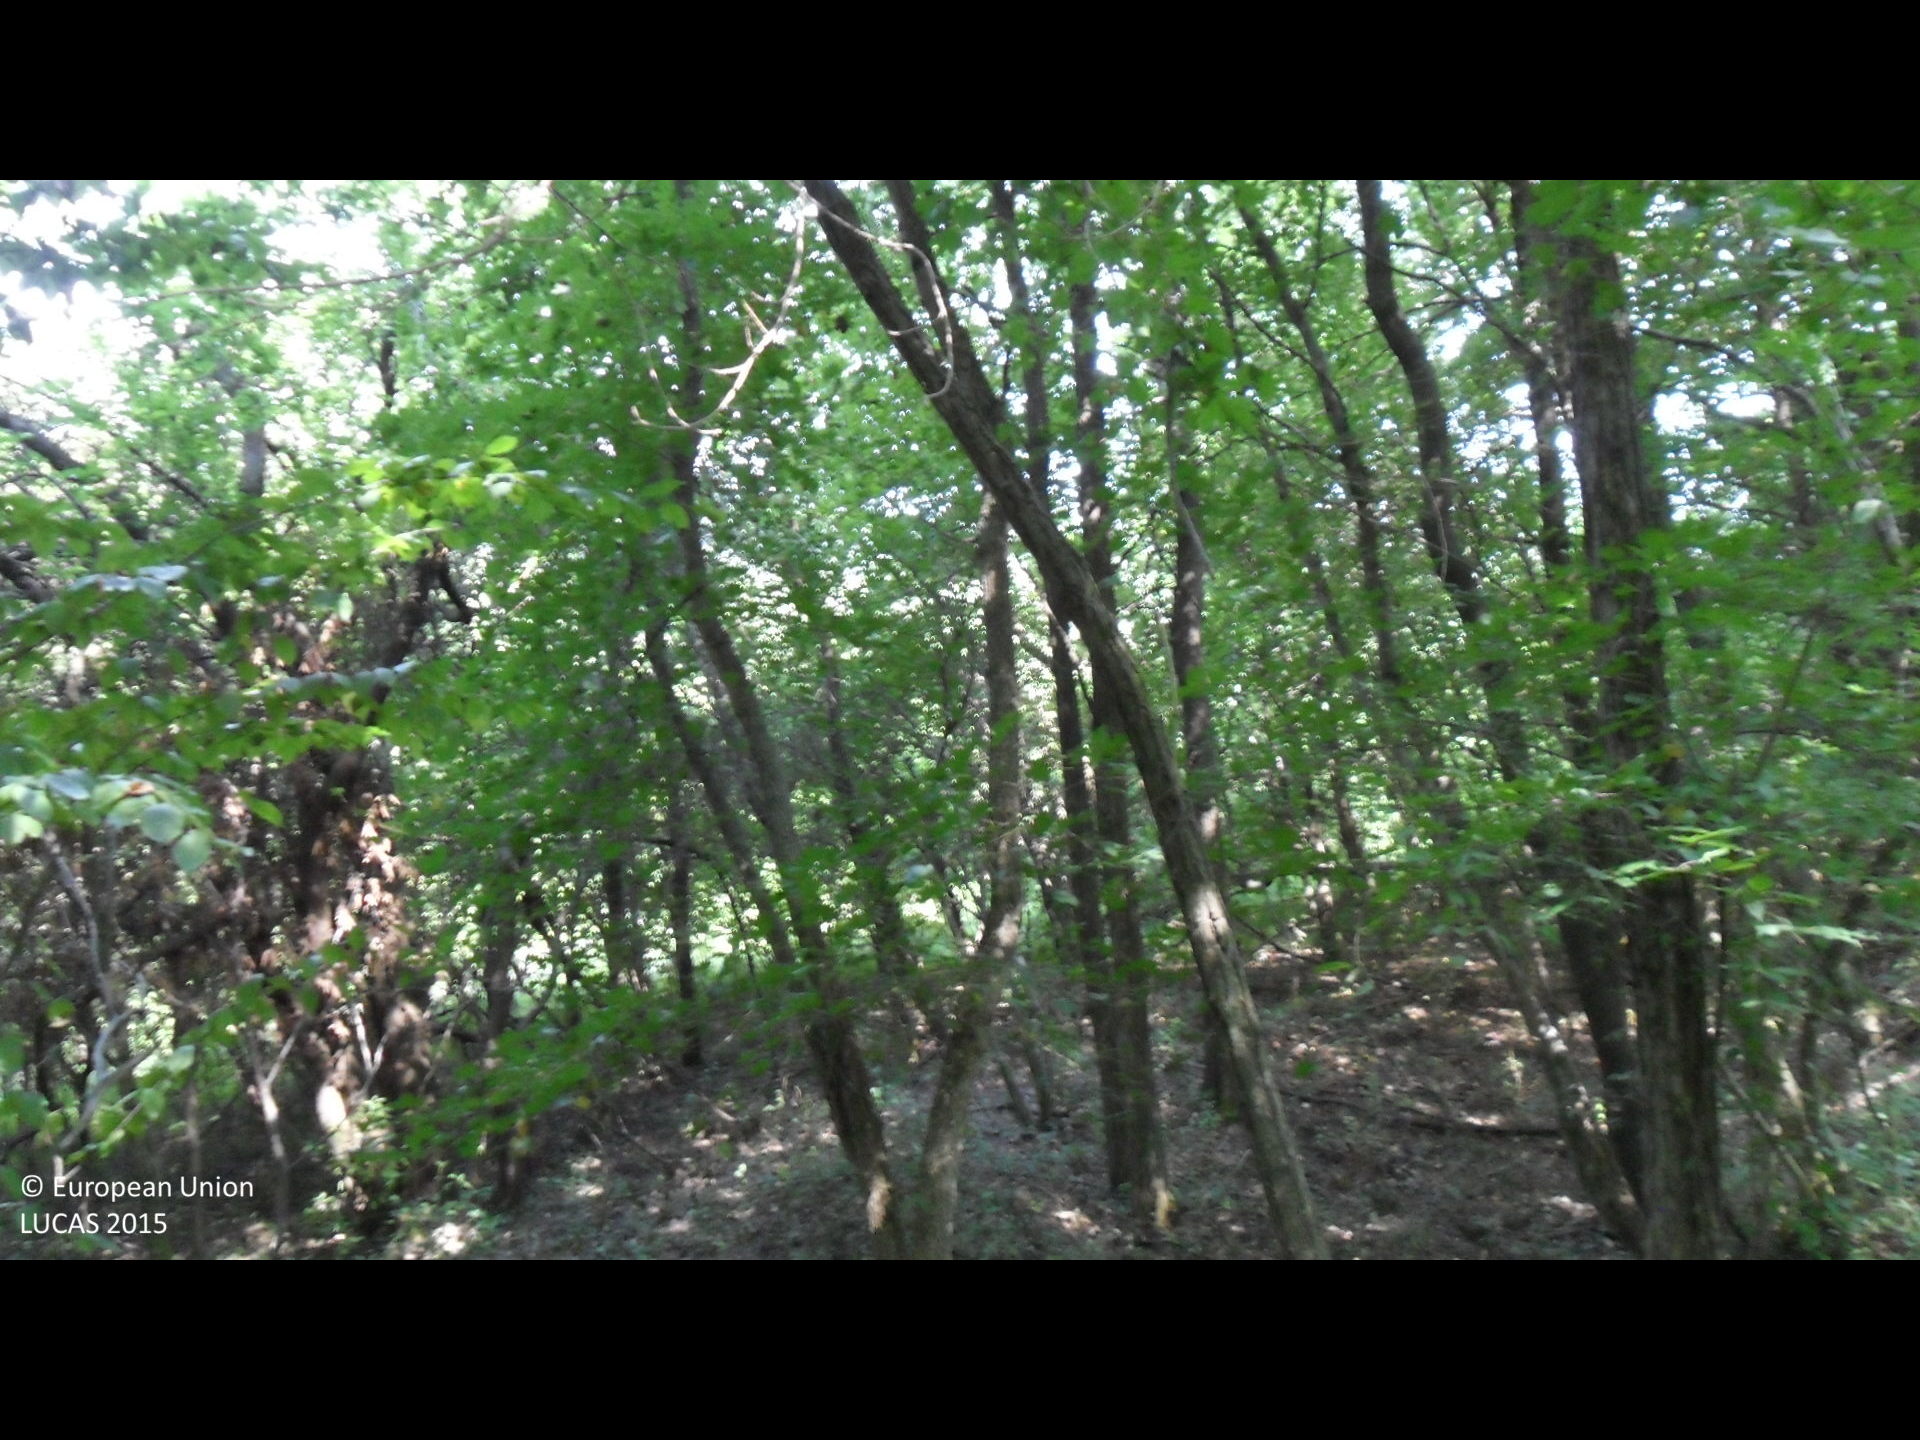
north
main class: Woodland
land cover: Broadleaved woodland
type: mesophytic deciduous forest
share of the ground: > 75 %
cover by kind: broadleaved forest trees 100 %
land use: Forestry
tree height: > 5 m
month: August
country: BG
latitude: 43.2718
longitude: 26.2994
